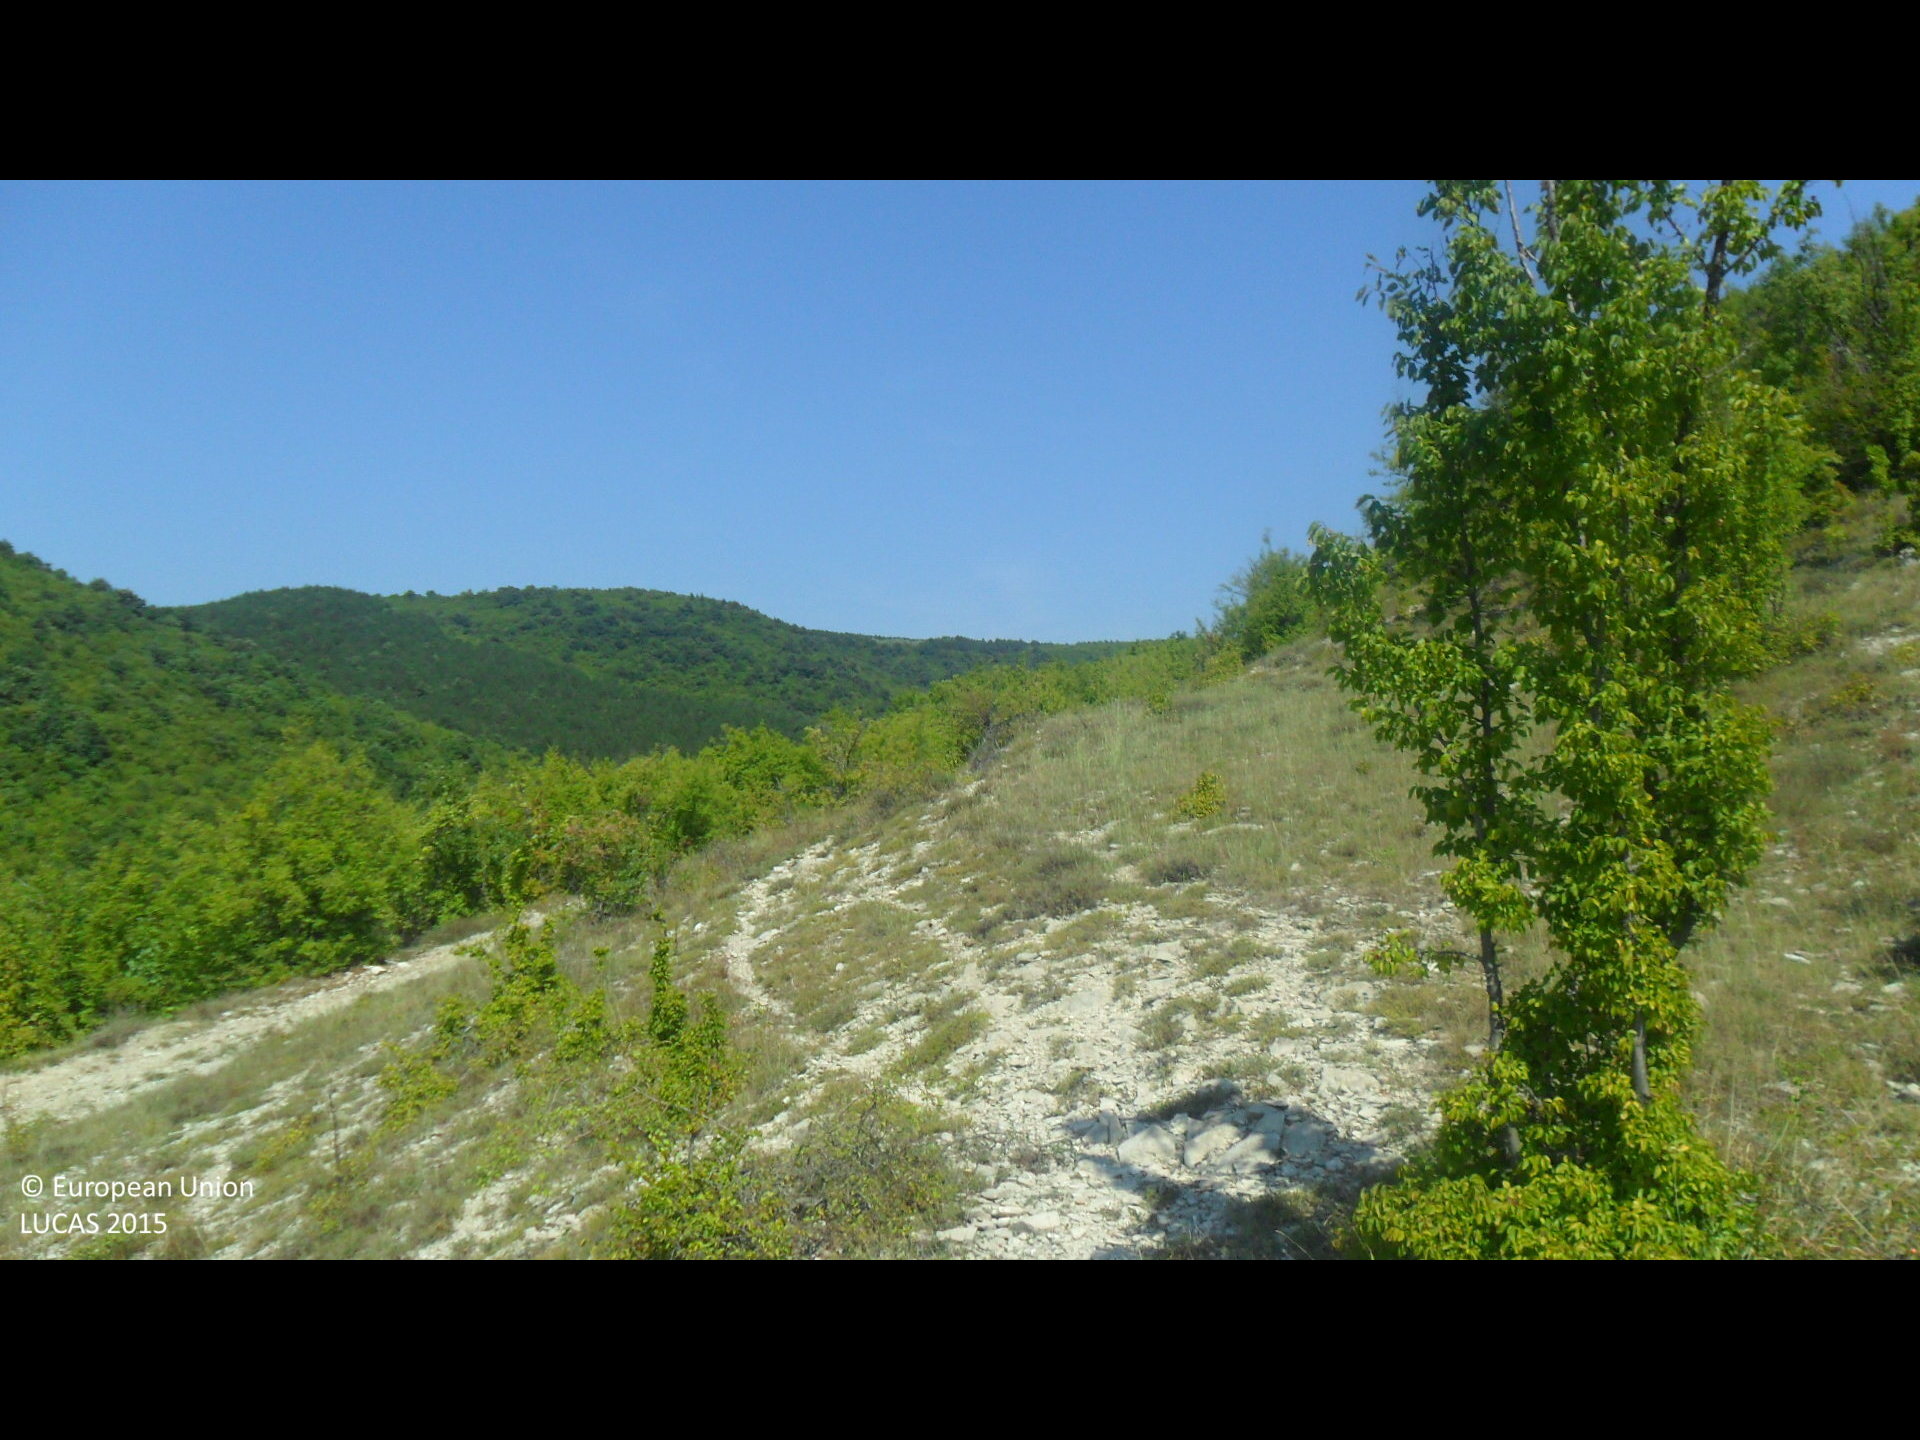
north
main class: Woodland
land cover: Broadleaved woodland
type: thermophilous deciduous forest
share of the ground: > 75 %
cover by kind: broadleaved forest trees 95 %, unconsolidated bare surface 5 %
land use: Forestry
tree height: > 5 m
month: September
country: BG
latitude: 43.1465
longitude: 26.6168
